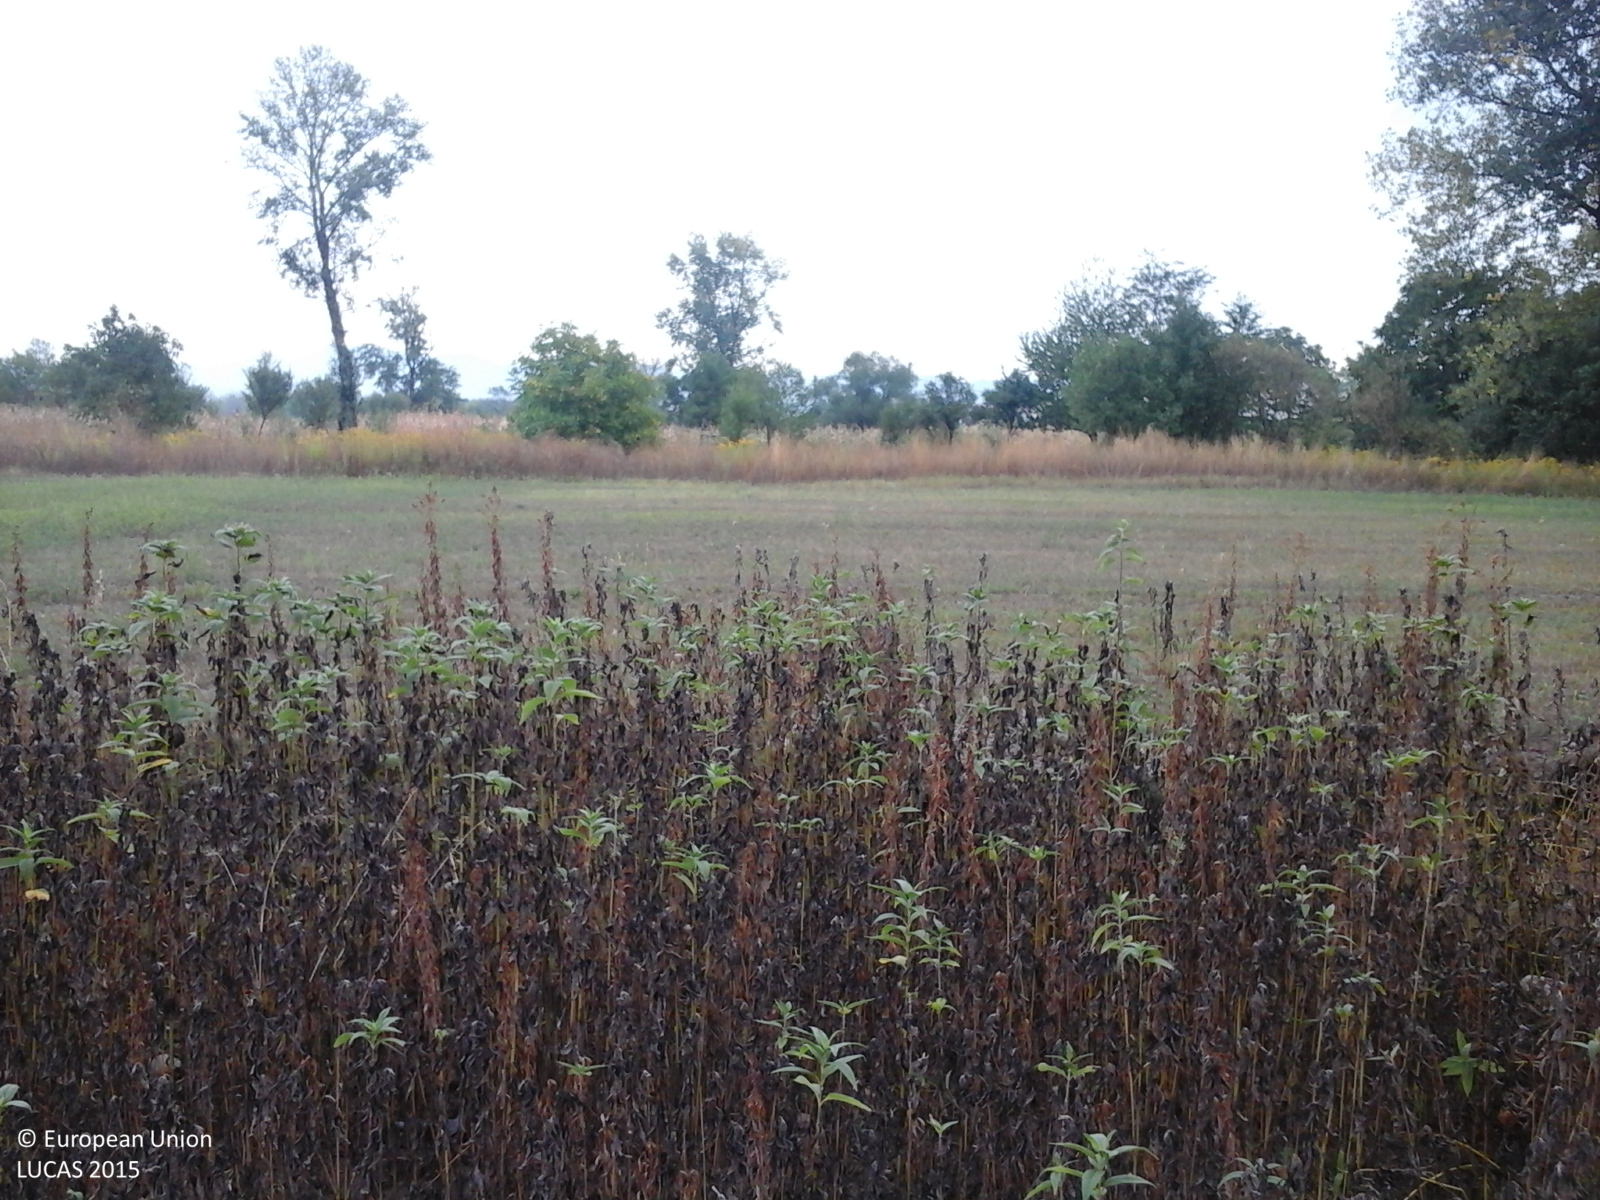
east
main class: Grassland
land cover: Spontaneously vegetated surfaces
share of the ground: > 75 %
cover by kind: herbaceous plants 100 %
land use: Fallow land
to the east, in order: Spontaneously vegetated surfaces; Lucerne; Spontaneously vegetated surfaces; Grassland with sparse tree/shrub cover; Other fruit trees and berries; Abandoned hedges; Lucerne; Maize; Other root crops; Potatoes; Other root crops; Potatoes; Maize; Single bushes/trees; Grassland without tree/shrub cover; Abandoned hedges; Shruby margins; Tracks; Spontaneously vegetated surfaces; Abandoned hedges; Lucerne; Other fresh vegetables
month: September
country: RO
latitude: 47.9418
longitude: 23.8862
